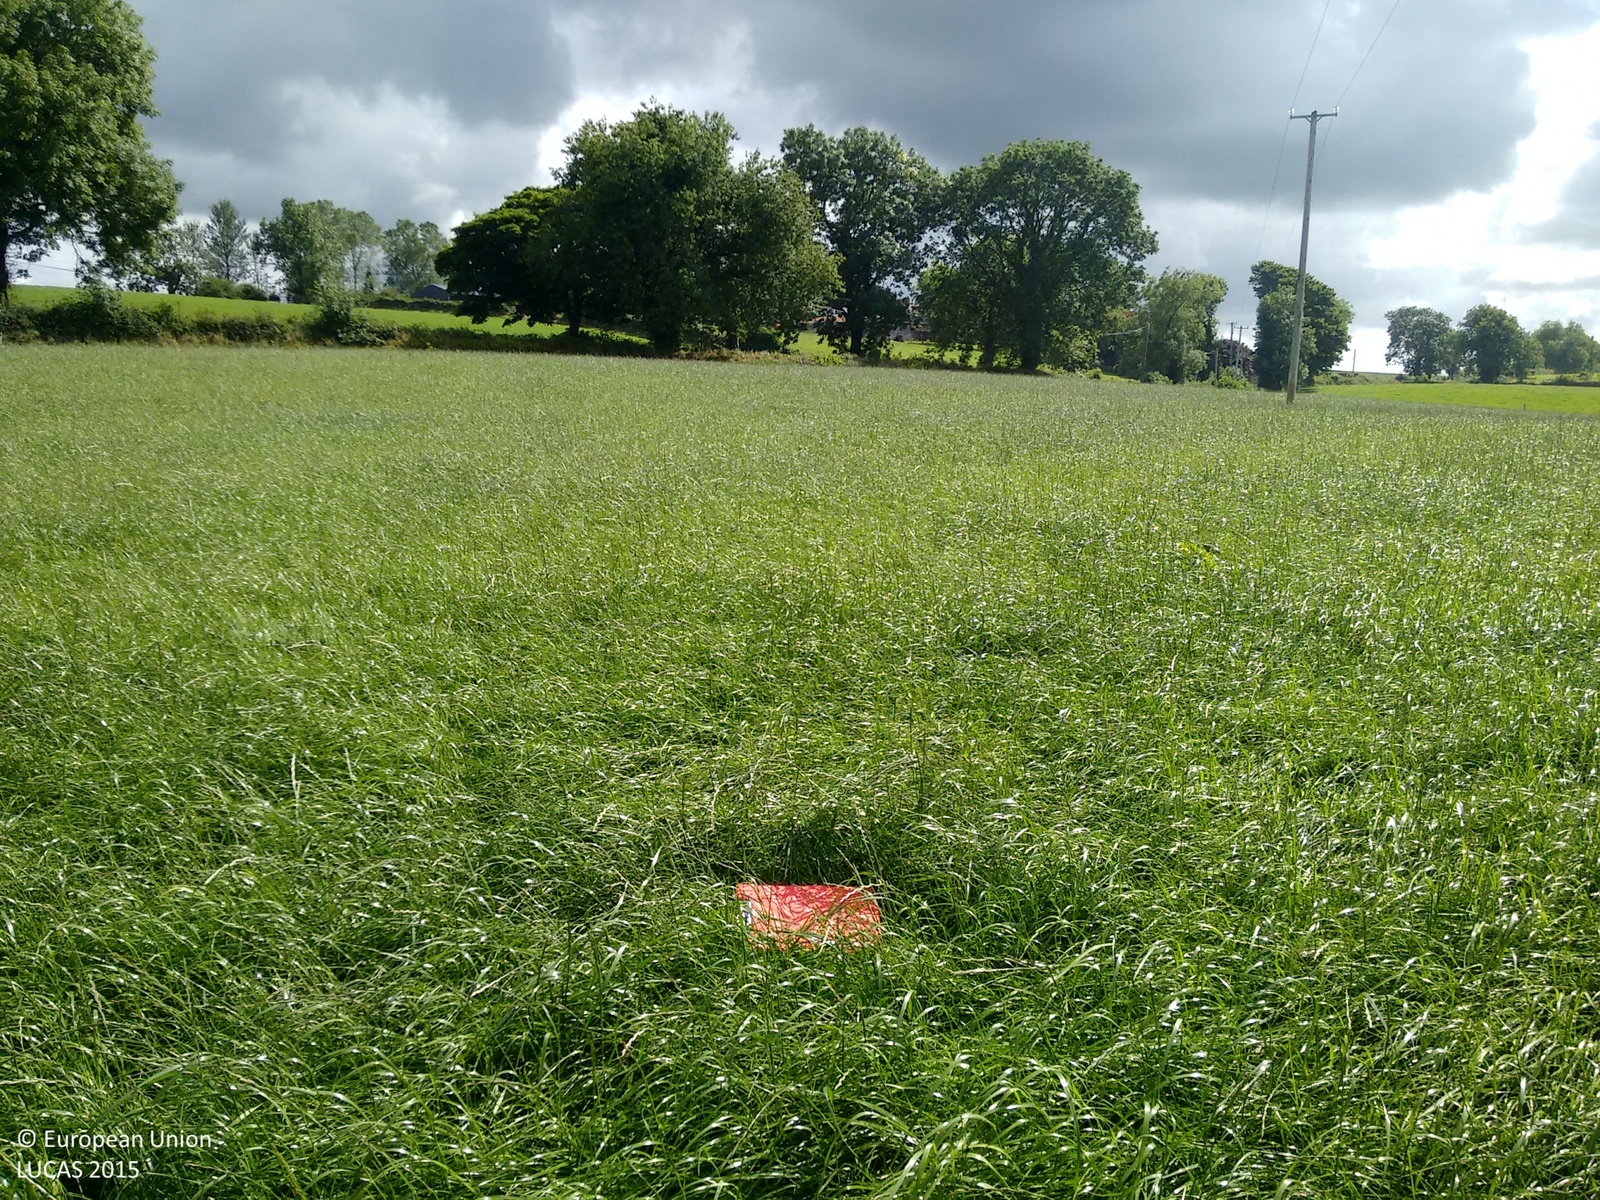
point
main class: Cropland
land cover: Temporary grasslands
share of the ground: > 75 %
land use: Agriculture (excluding fallow land and kitchen gardens)
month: August
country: IE
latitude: 54.0400
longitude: -6.5109
